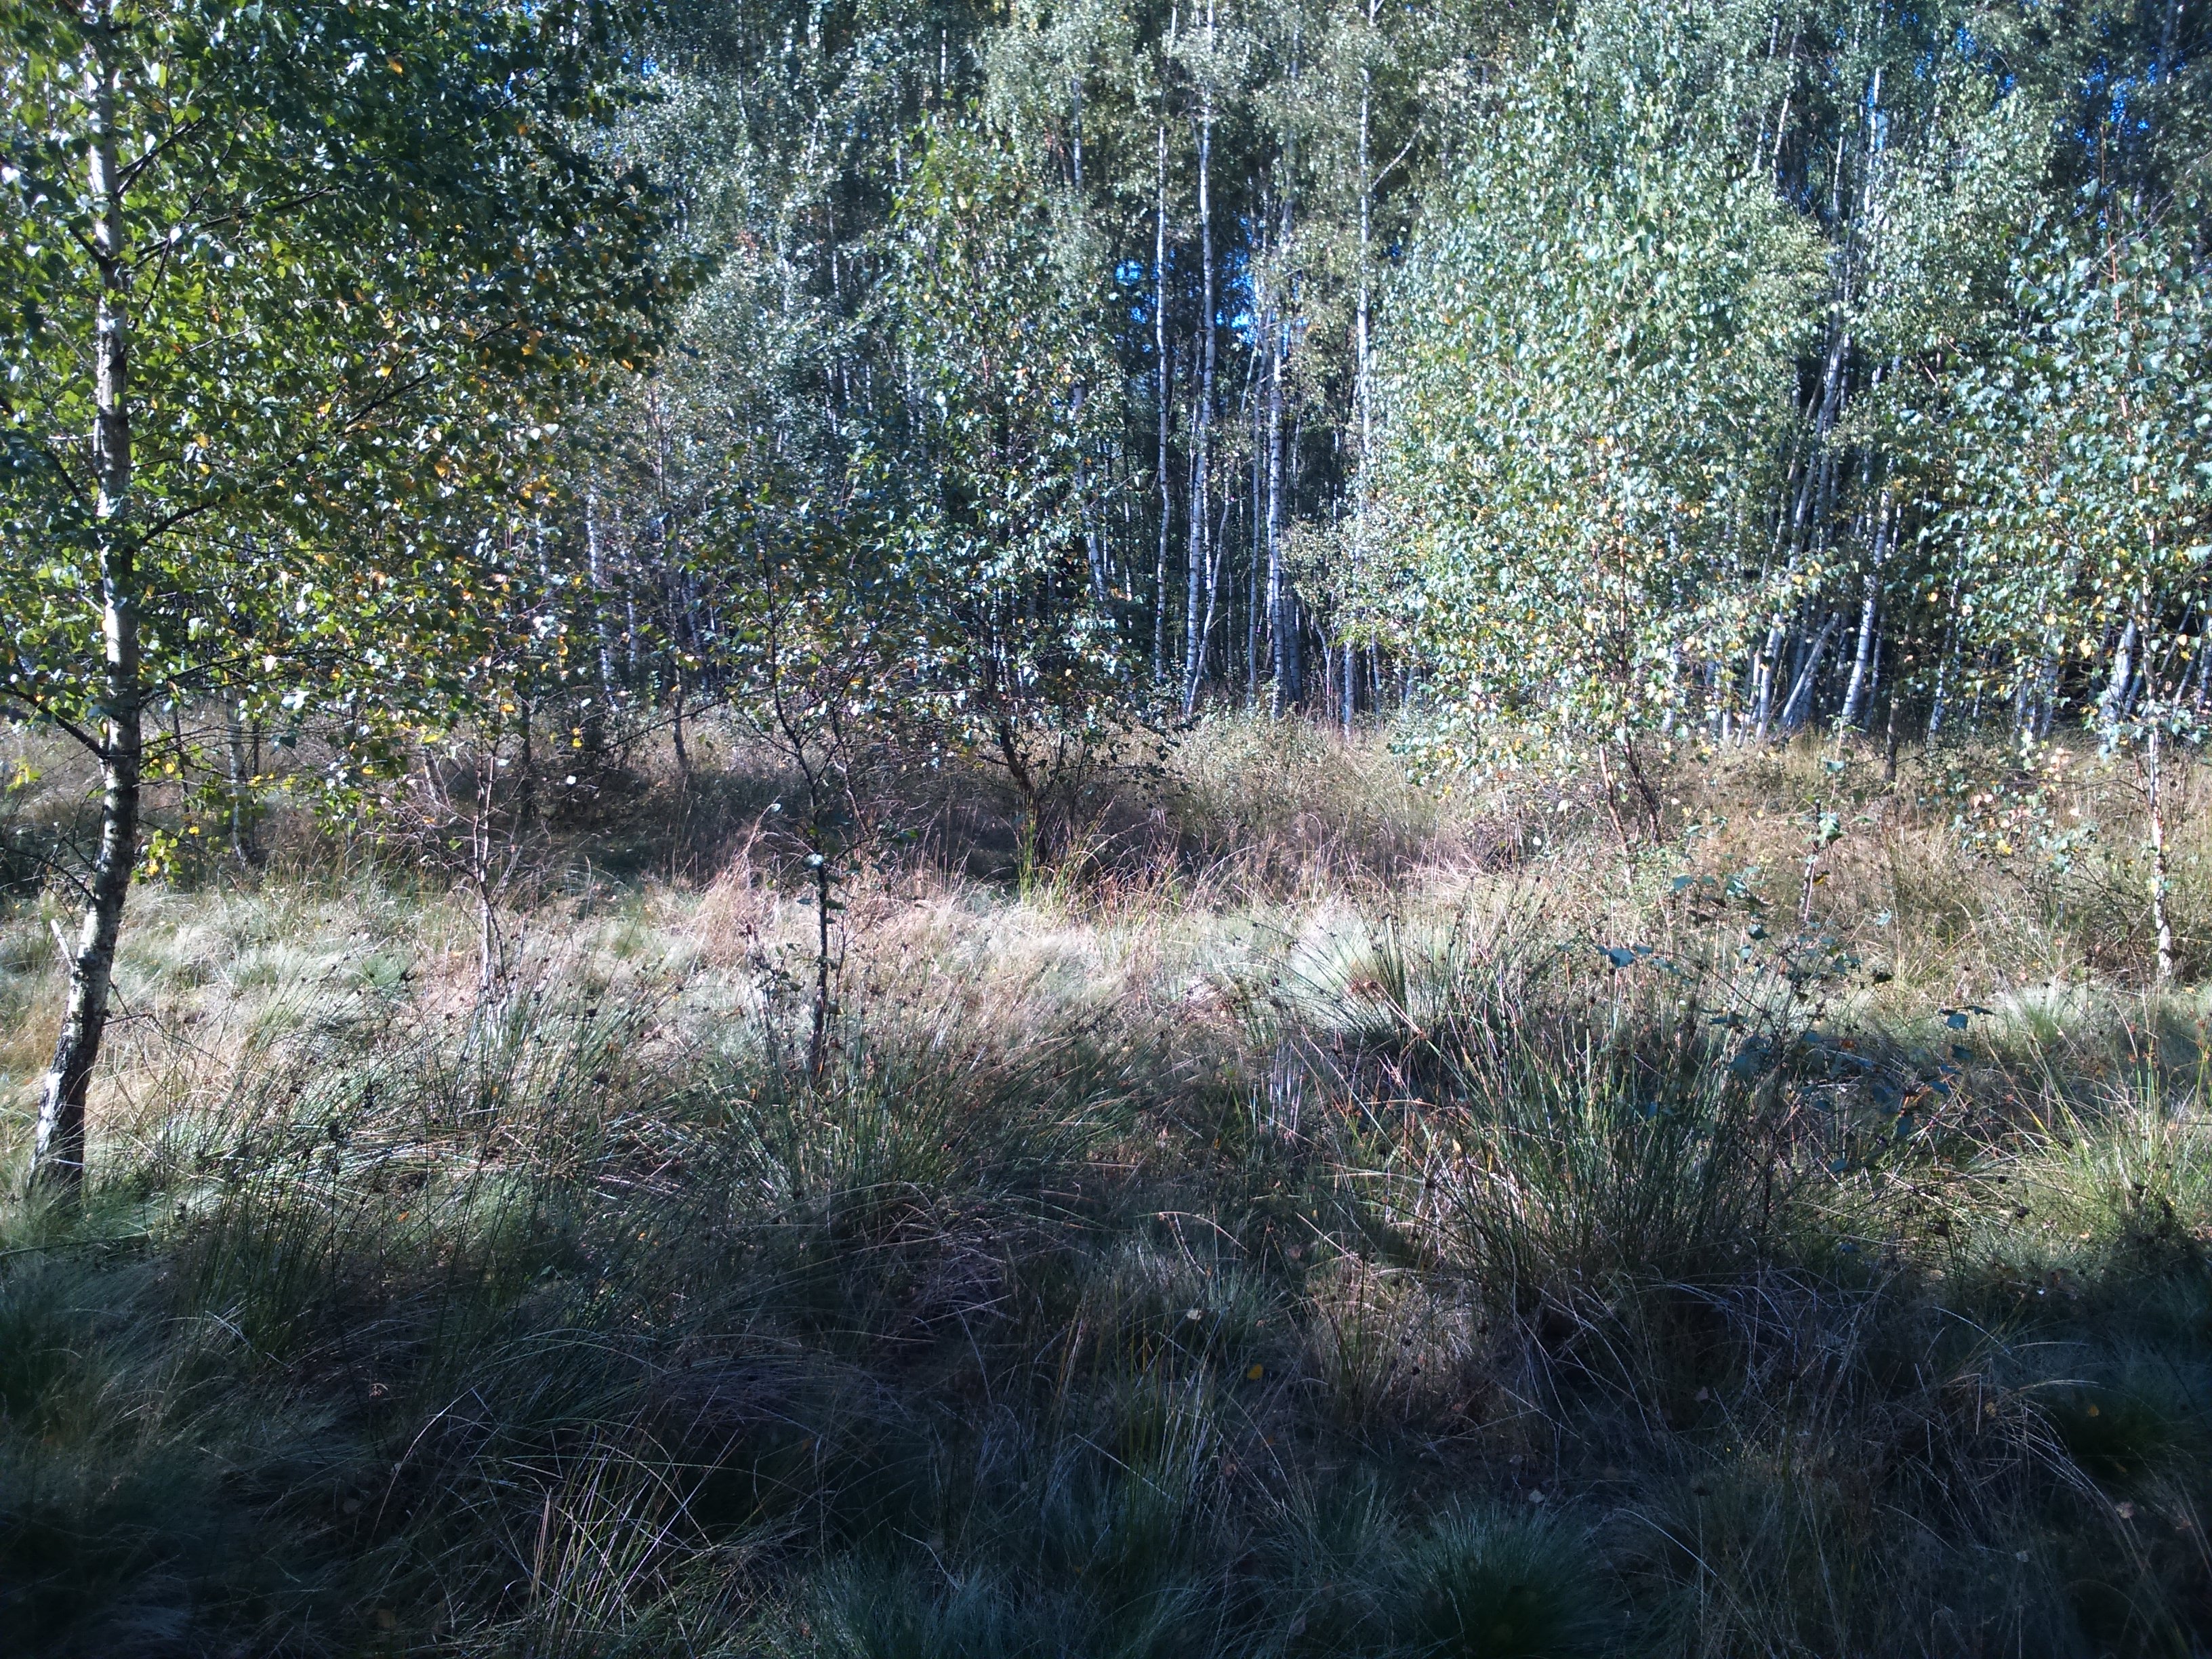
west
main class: Woodland
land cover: Broadleaved woodland
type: mesophytic deciduous forest
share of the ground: 25 - 50 %
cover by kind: herbaceous plants 55 %, broadleaved forest trees 45 %
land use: Forestry
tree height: > 5 m
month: September
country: PL
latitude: 52.5020
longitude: 21.9158
